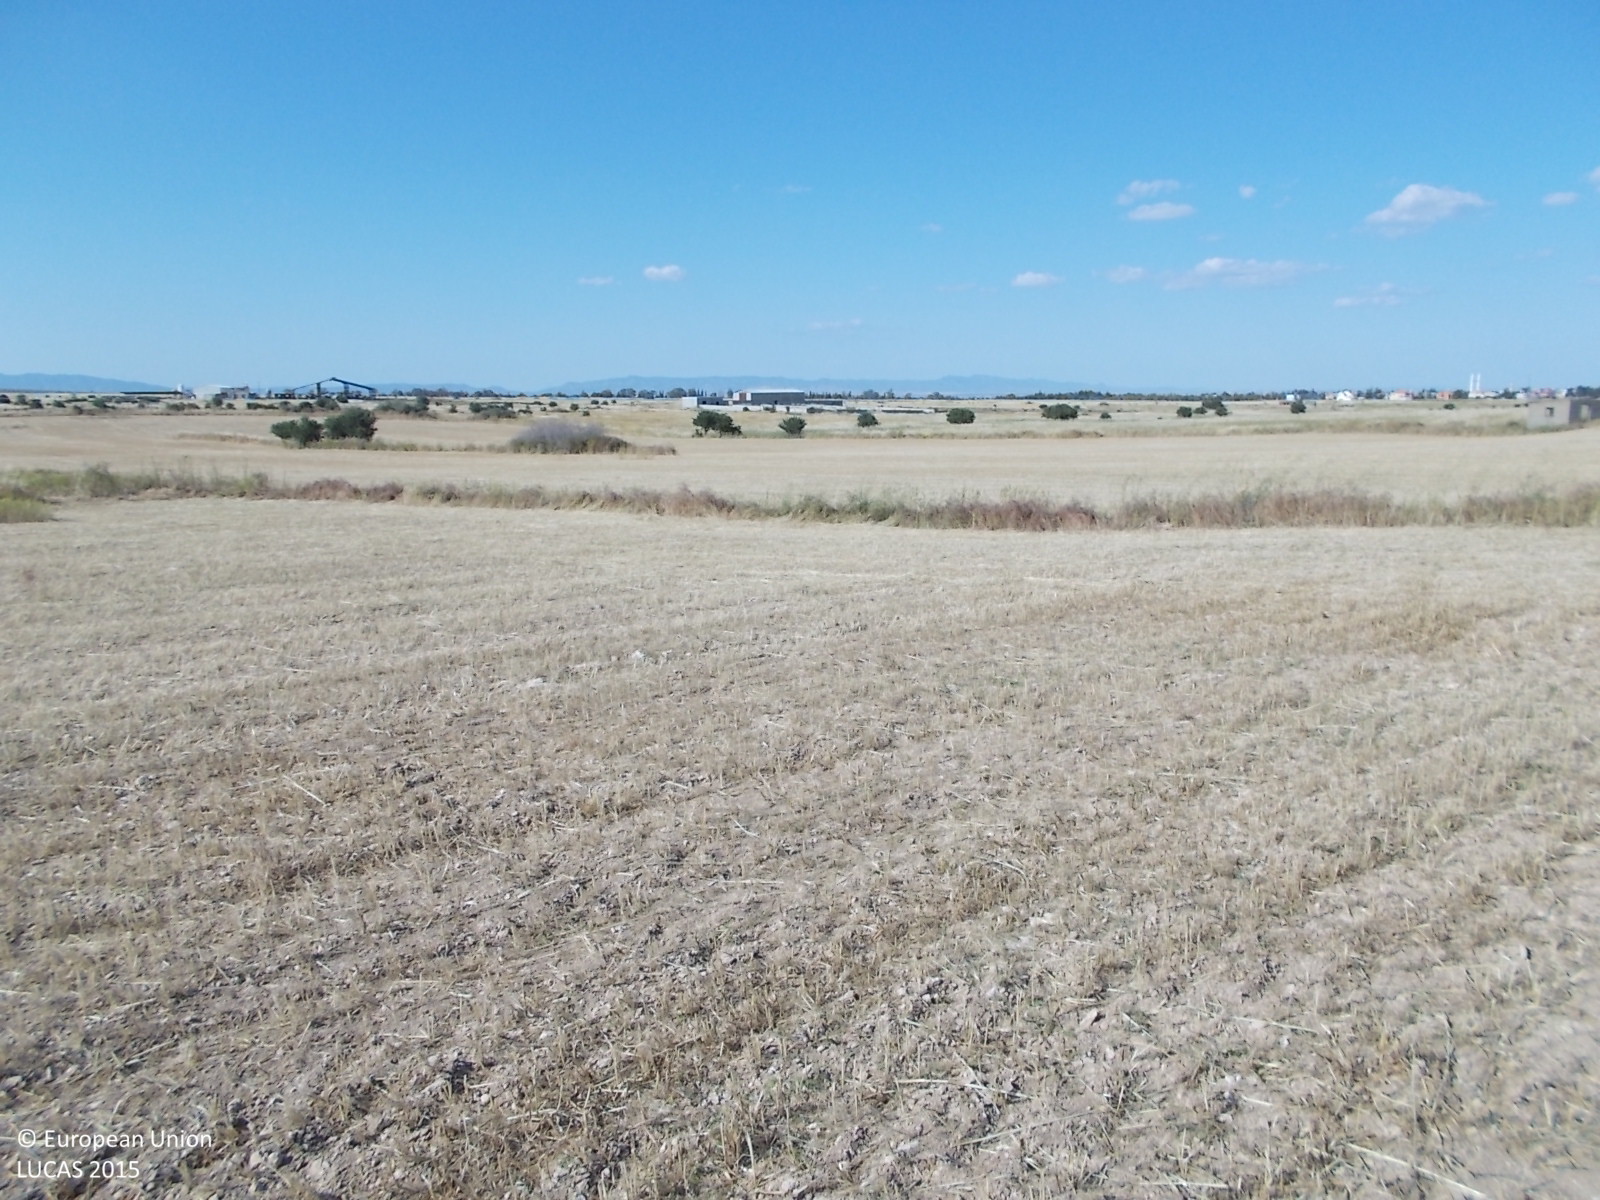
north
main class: Cropland
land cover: Common wheat
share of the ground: < 10 %
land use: Agriculture (excluding fallow land and kitchen gardens)
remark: Harvested field
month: April
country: CY
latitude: 35.0276
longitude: 33.6911
